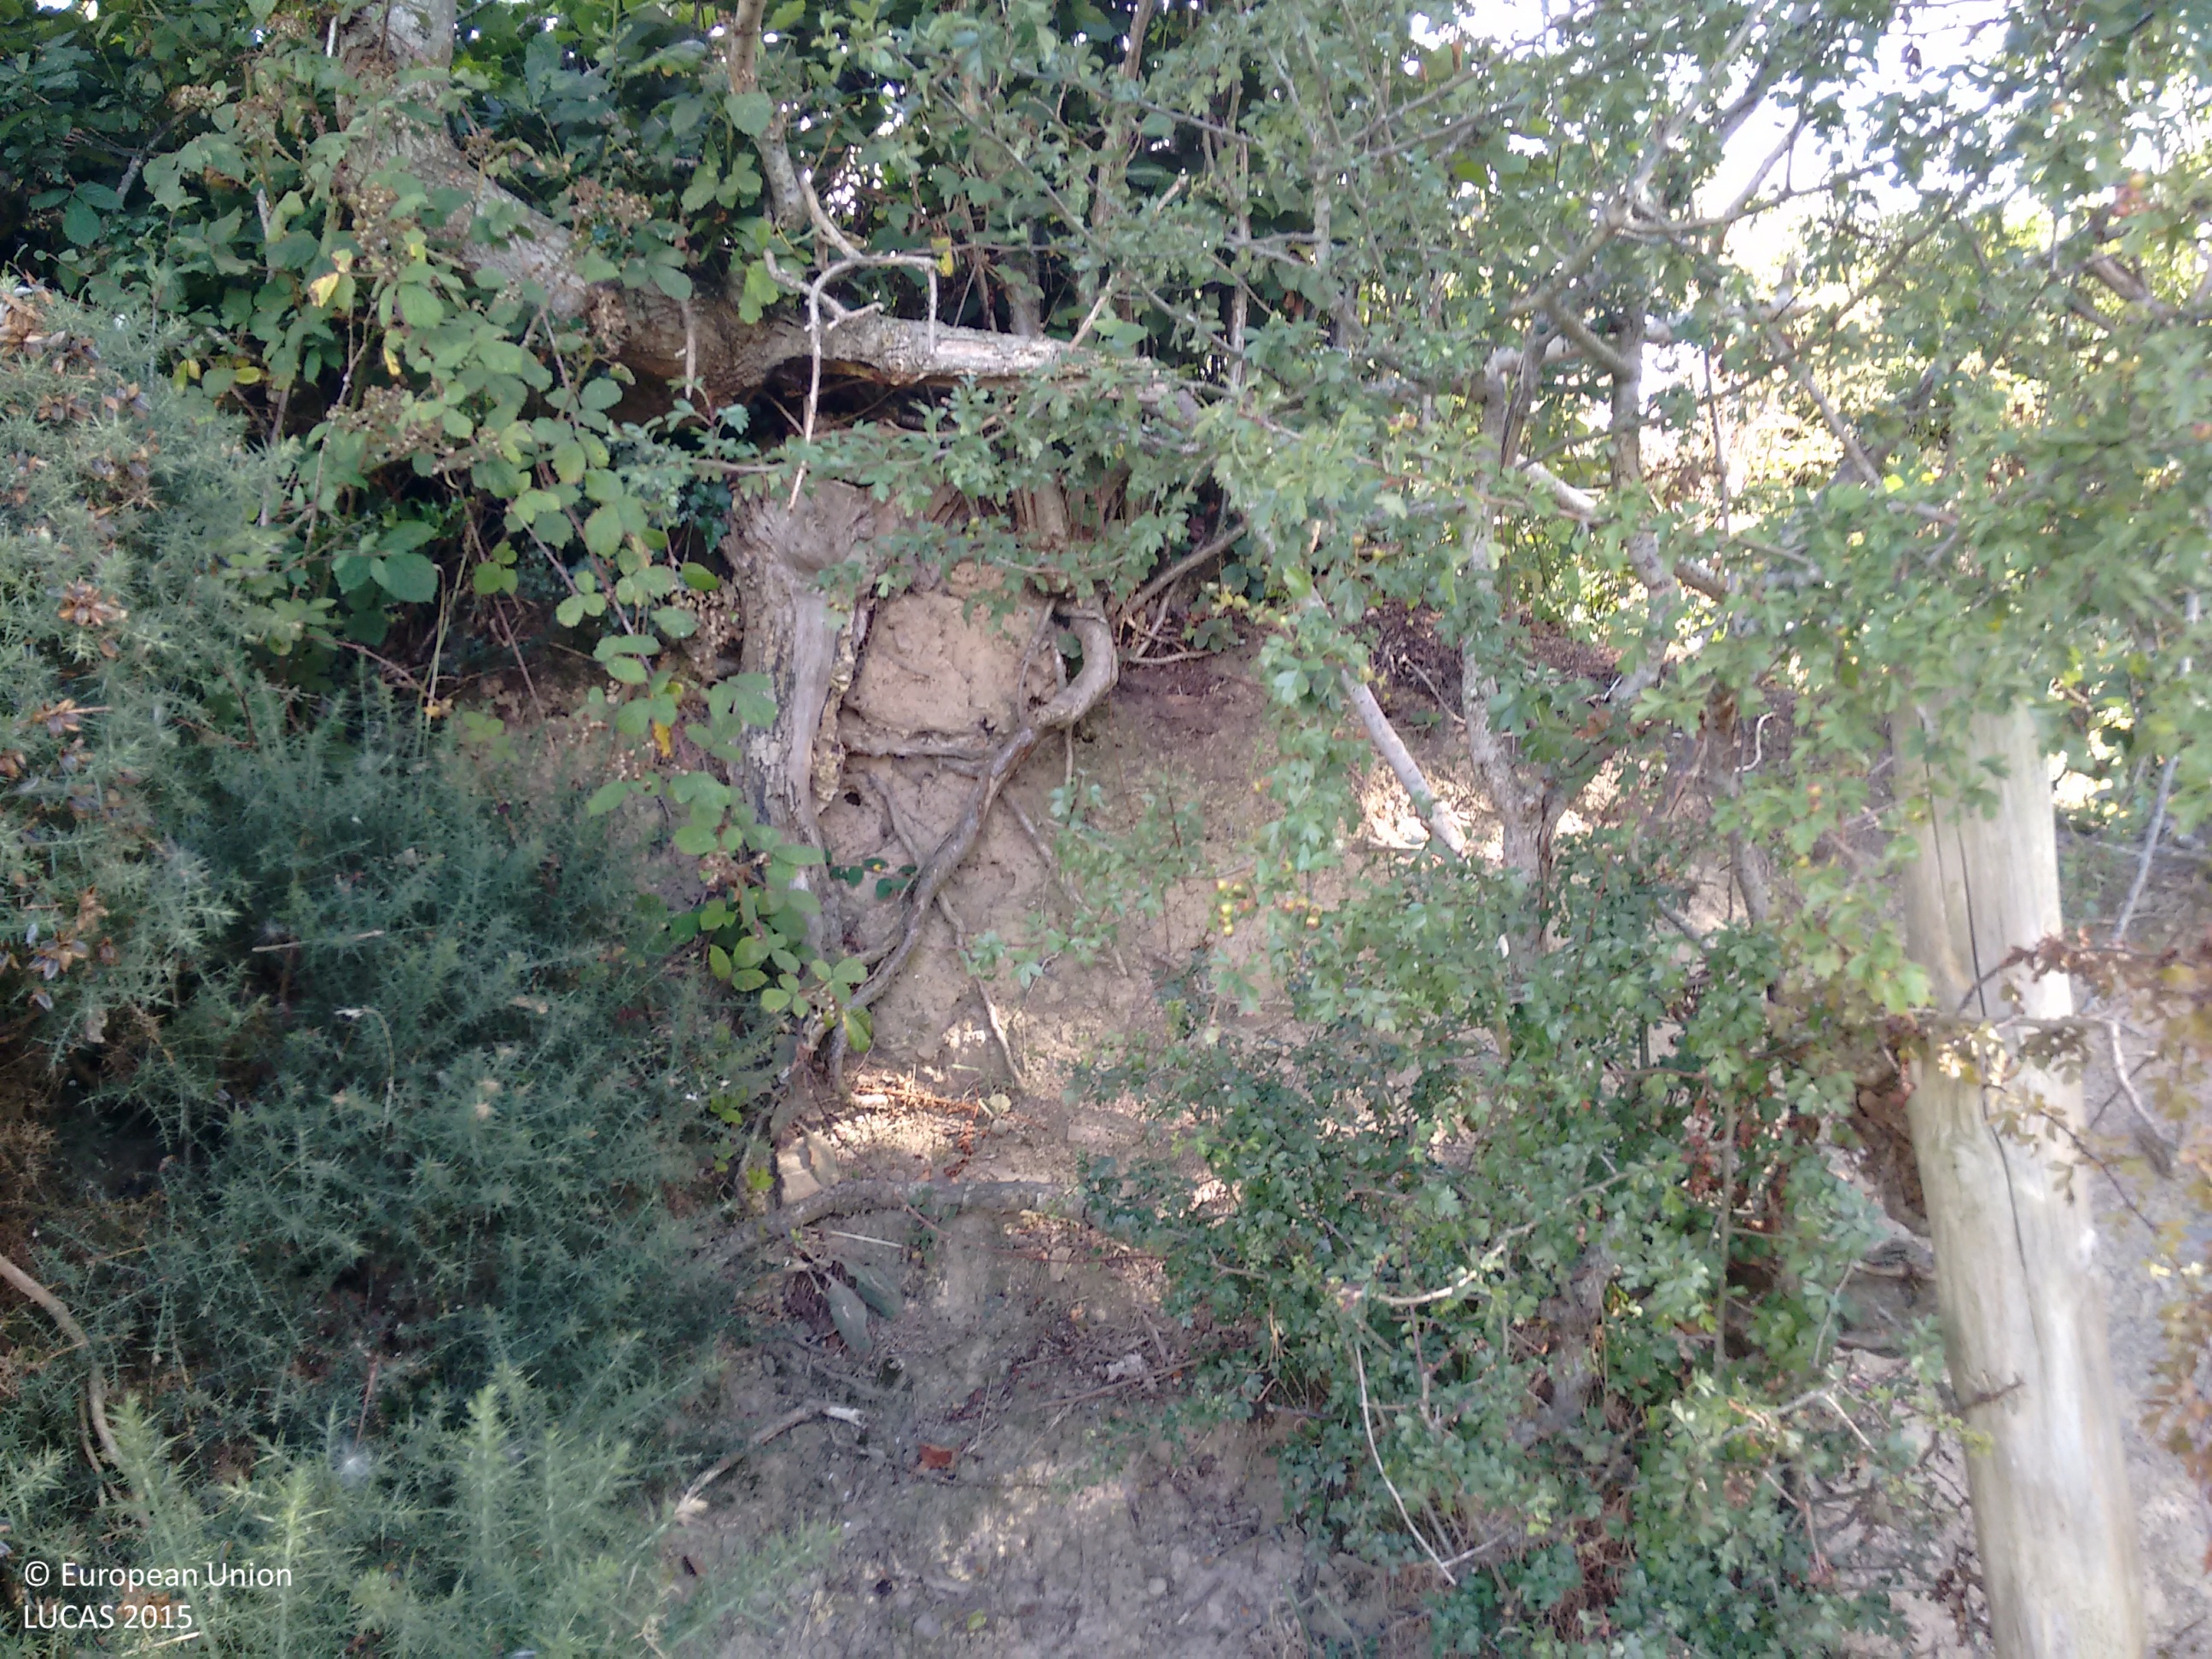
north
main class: Grassland
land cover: Grassland without tree/shrub cover
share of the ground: > 75 %
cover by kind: herbaceous plants 100 %
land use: Agriculture (excluding fallow land and kitchen gardens)
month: August
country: GB
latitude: 50.7339
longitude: -3.5884
